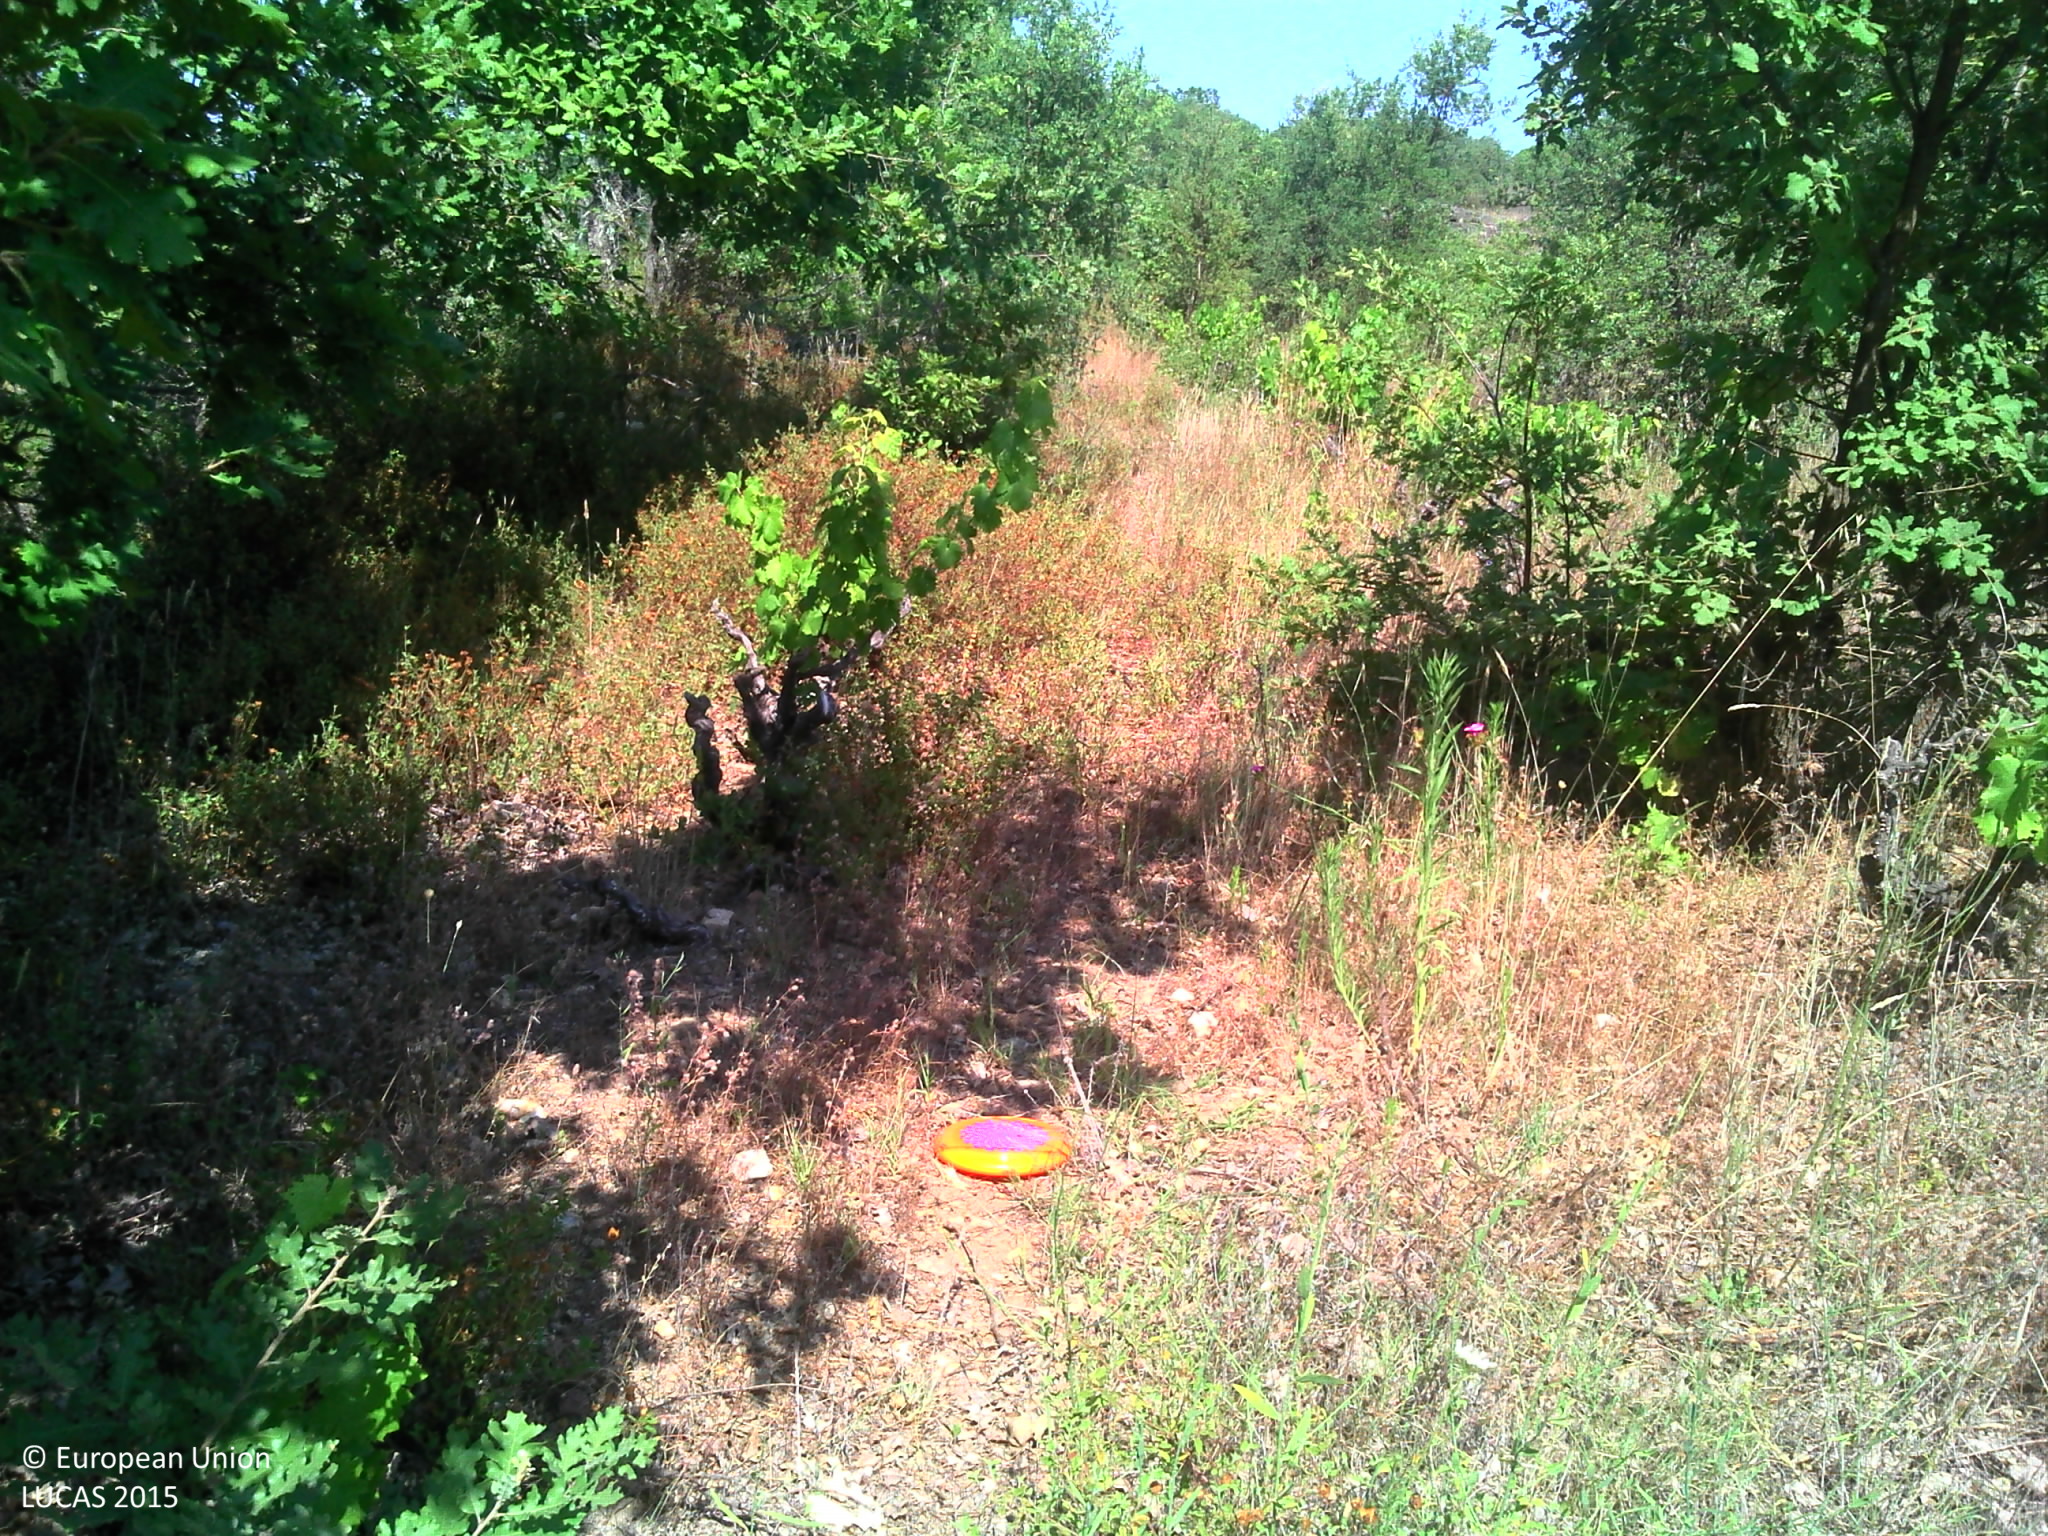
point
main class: Cropland
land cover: Vineyards
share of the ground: 25 - 50 %
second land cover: Grassland without tree/shrub cover
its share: 50 - 75 %
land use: Agriculture (excluding fallow land and kitchen gardens)
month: July
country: FR
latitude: 43.3677
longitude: 6.4178
